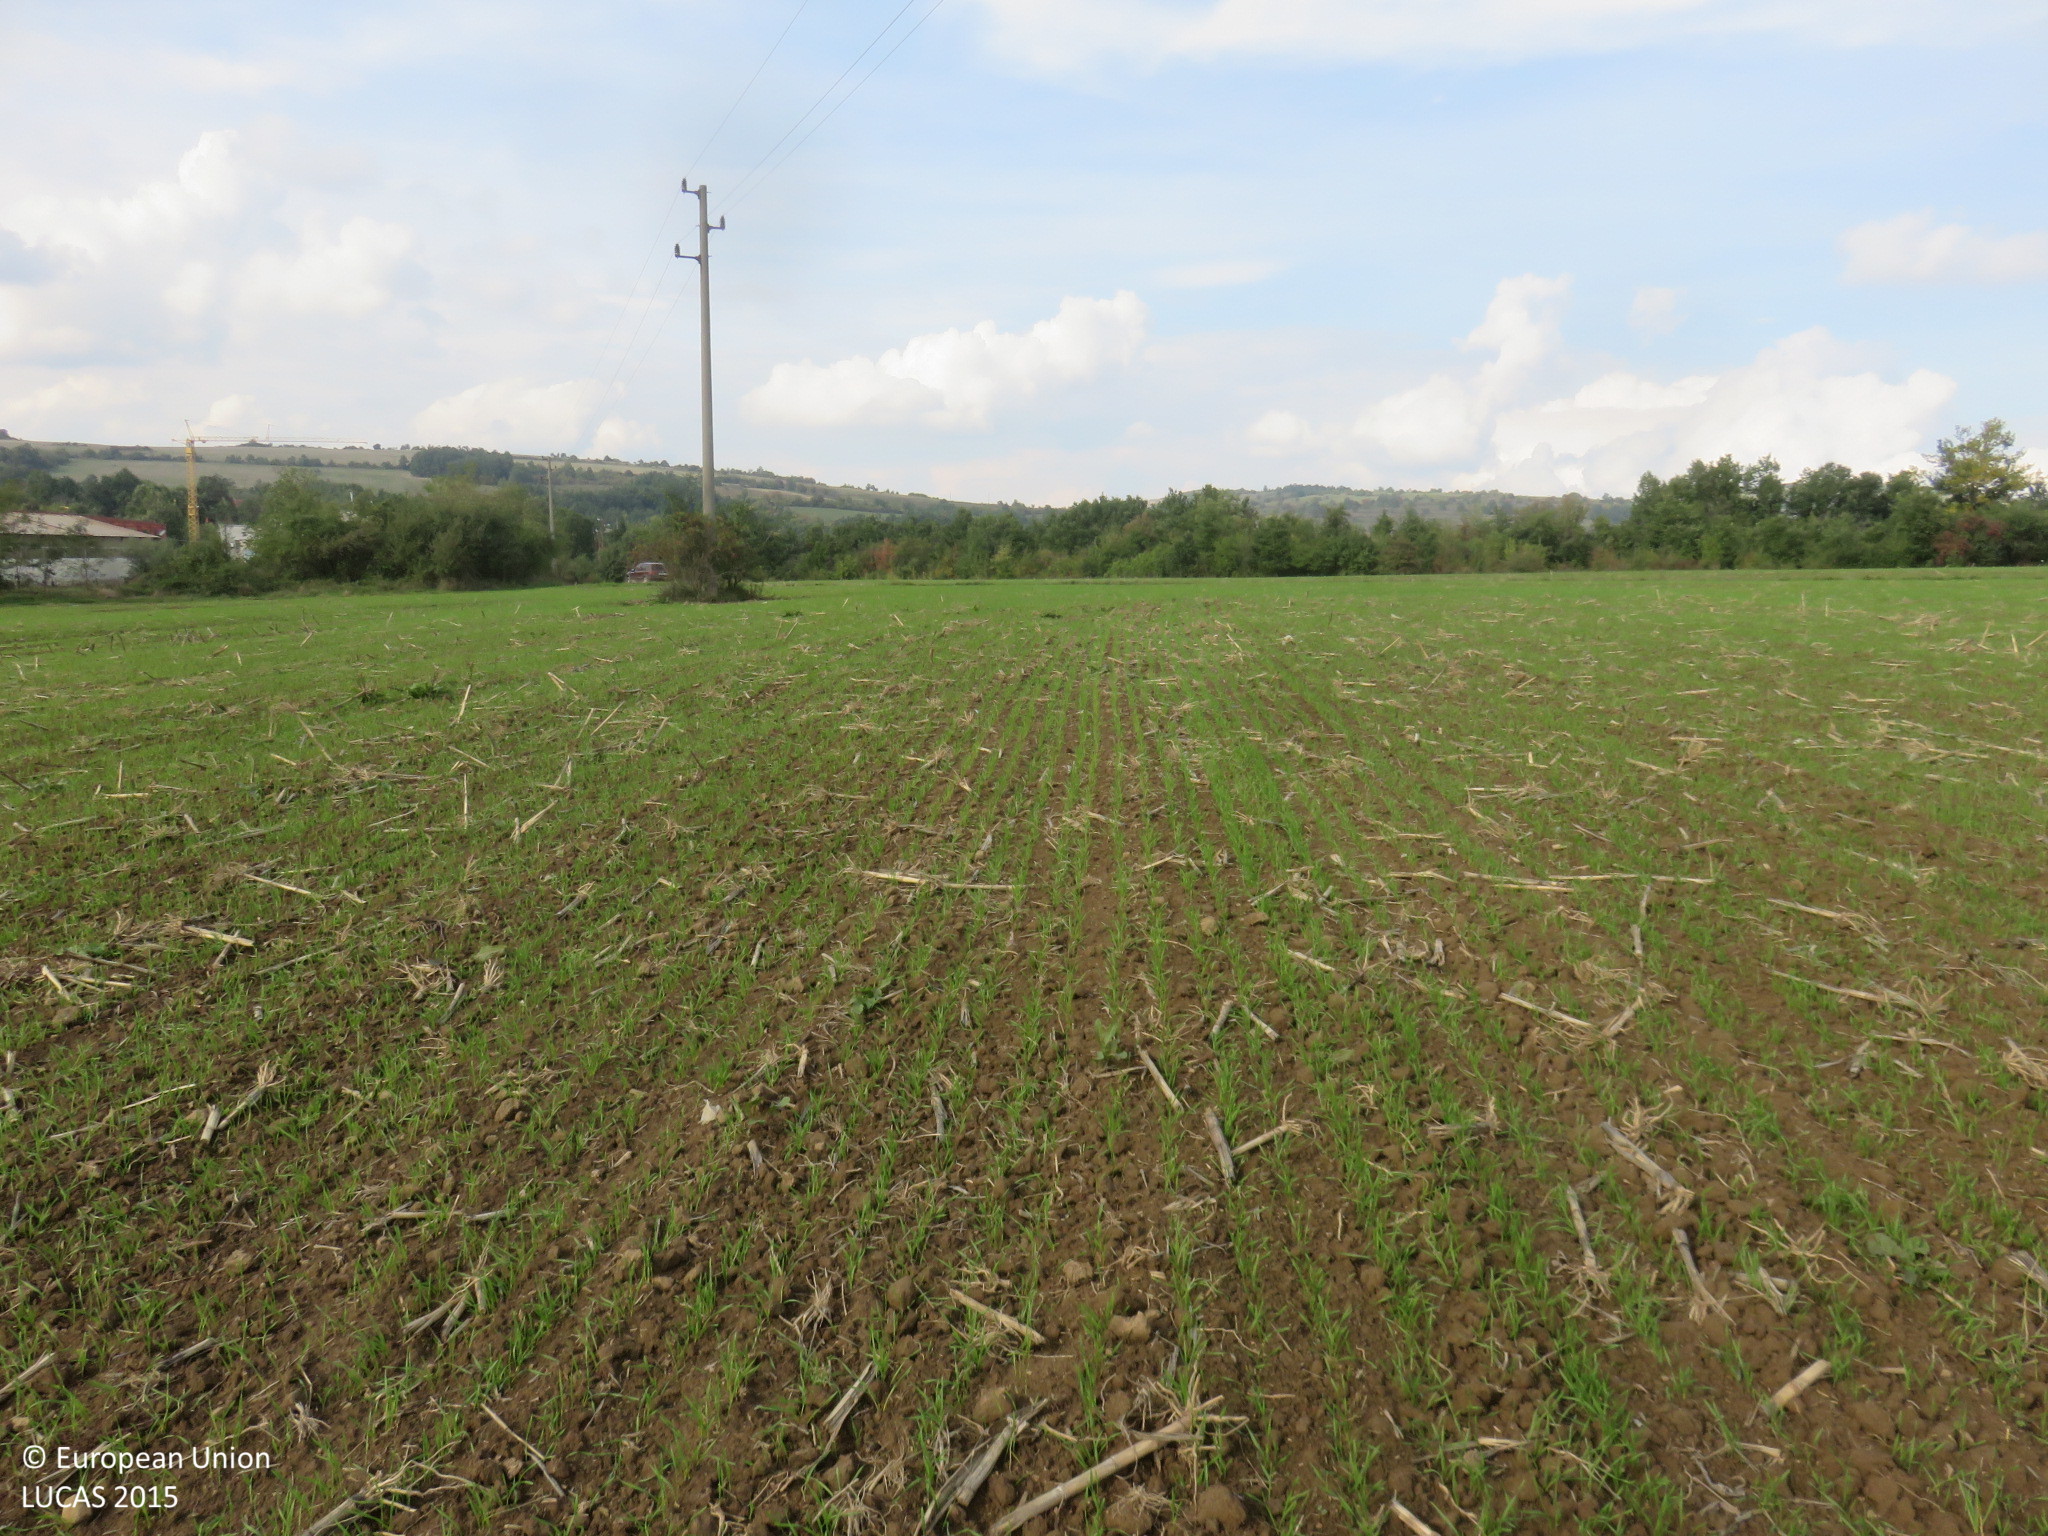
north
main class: Cropland
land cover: Maize
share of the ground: < 10 %
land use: Agriculture (excluding fallow land and kitchen gardens)
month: October
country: BG
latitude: 42.9392
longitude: 25.3788
